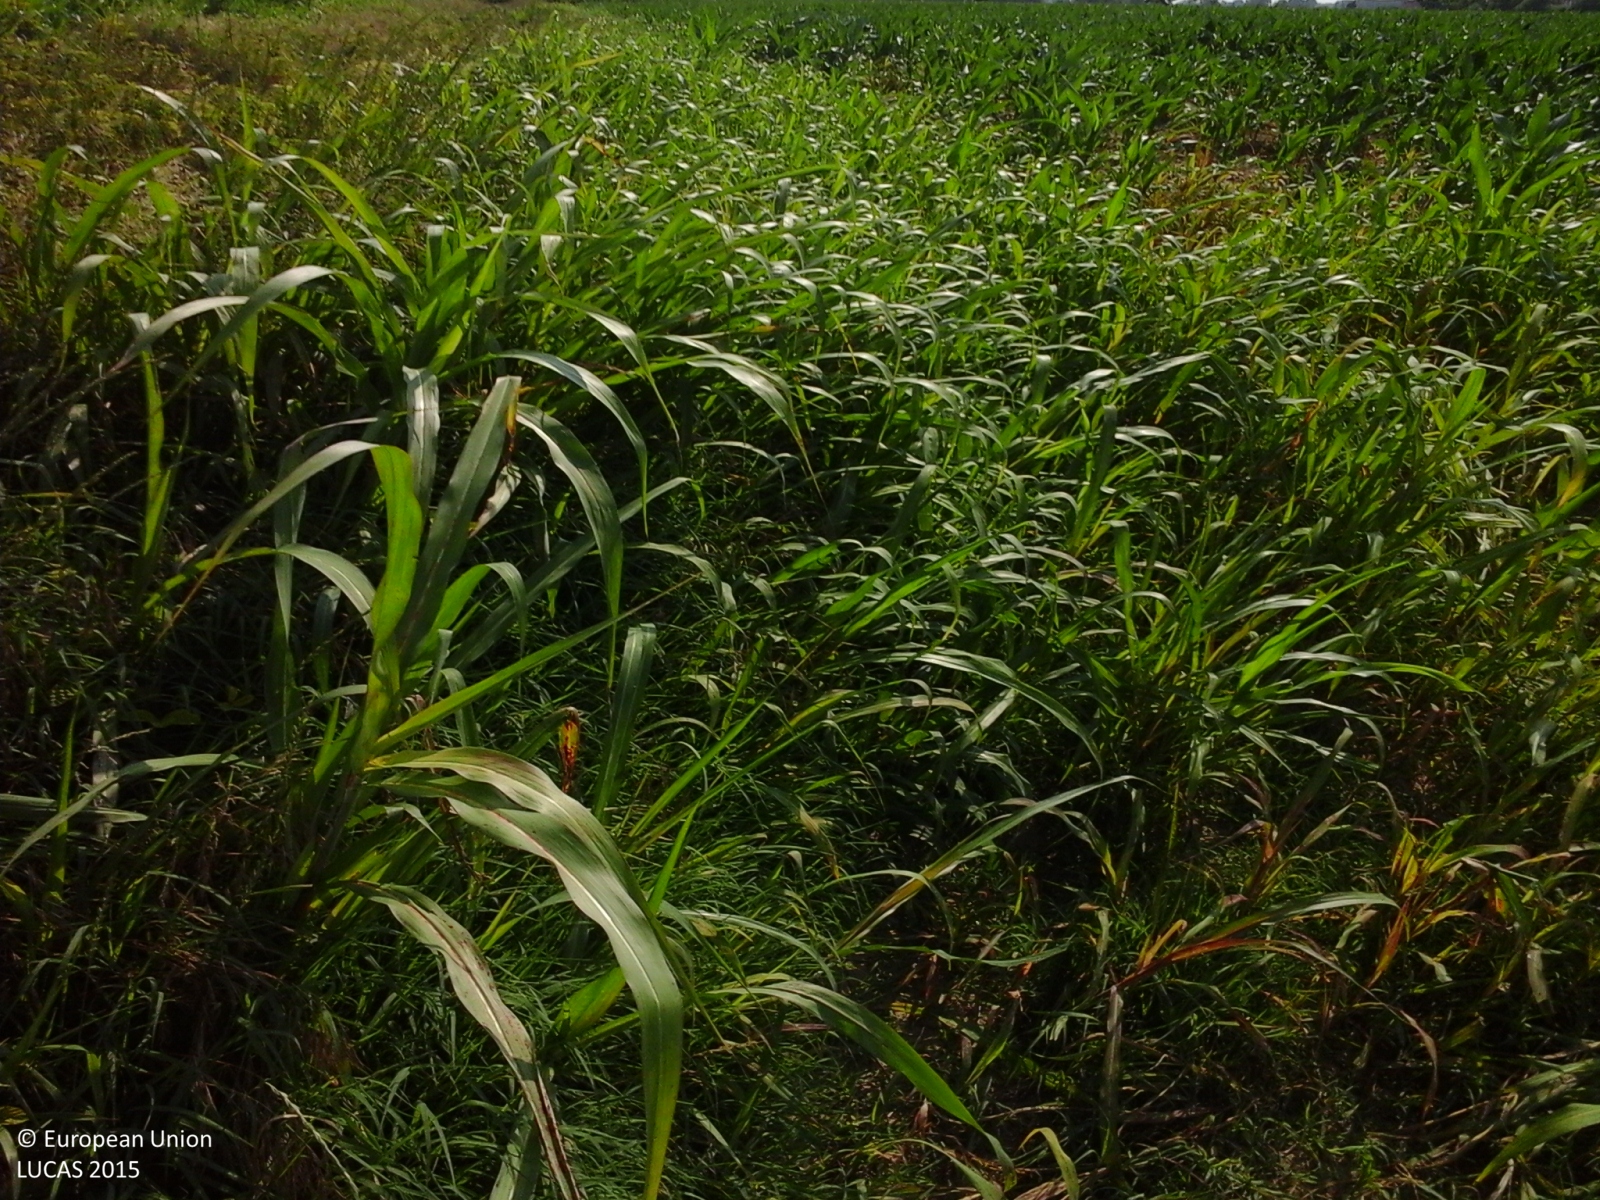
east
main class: Cropland
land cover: Maize
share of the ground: > 75 %
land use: Agriculture (excluding fallow land and kitchen gardens)
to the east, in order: Maize; Grass margins; Ditches and canals; Grass margins; Maize
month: June
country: IT
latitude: 45.3236
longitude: 9.6562
